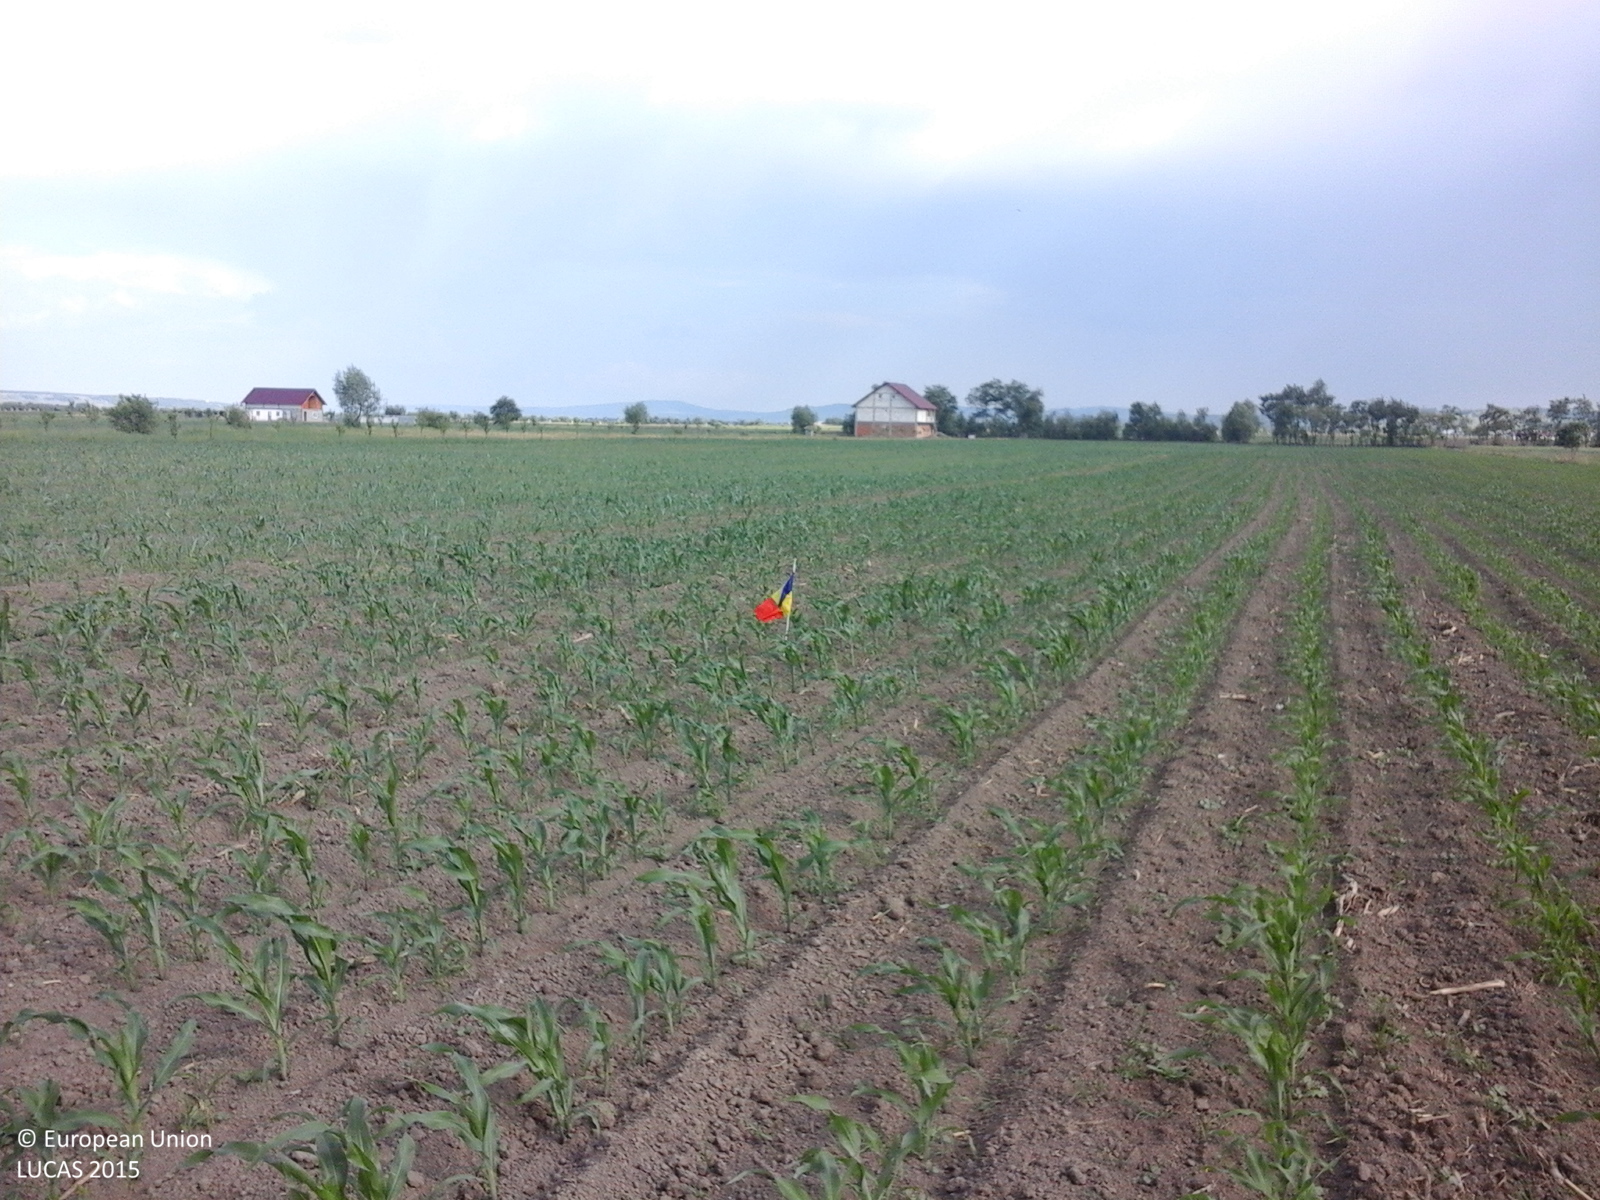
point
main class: Cropland
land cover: Maize
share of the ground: 10 - 25 %
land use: Agriculture (excluding fallow land and kitchen gardens)
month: June
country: RO
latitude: 46.7736
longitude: 26.5739
